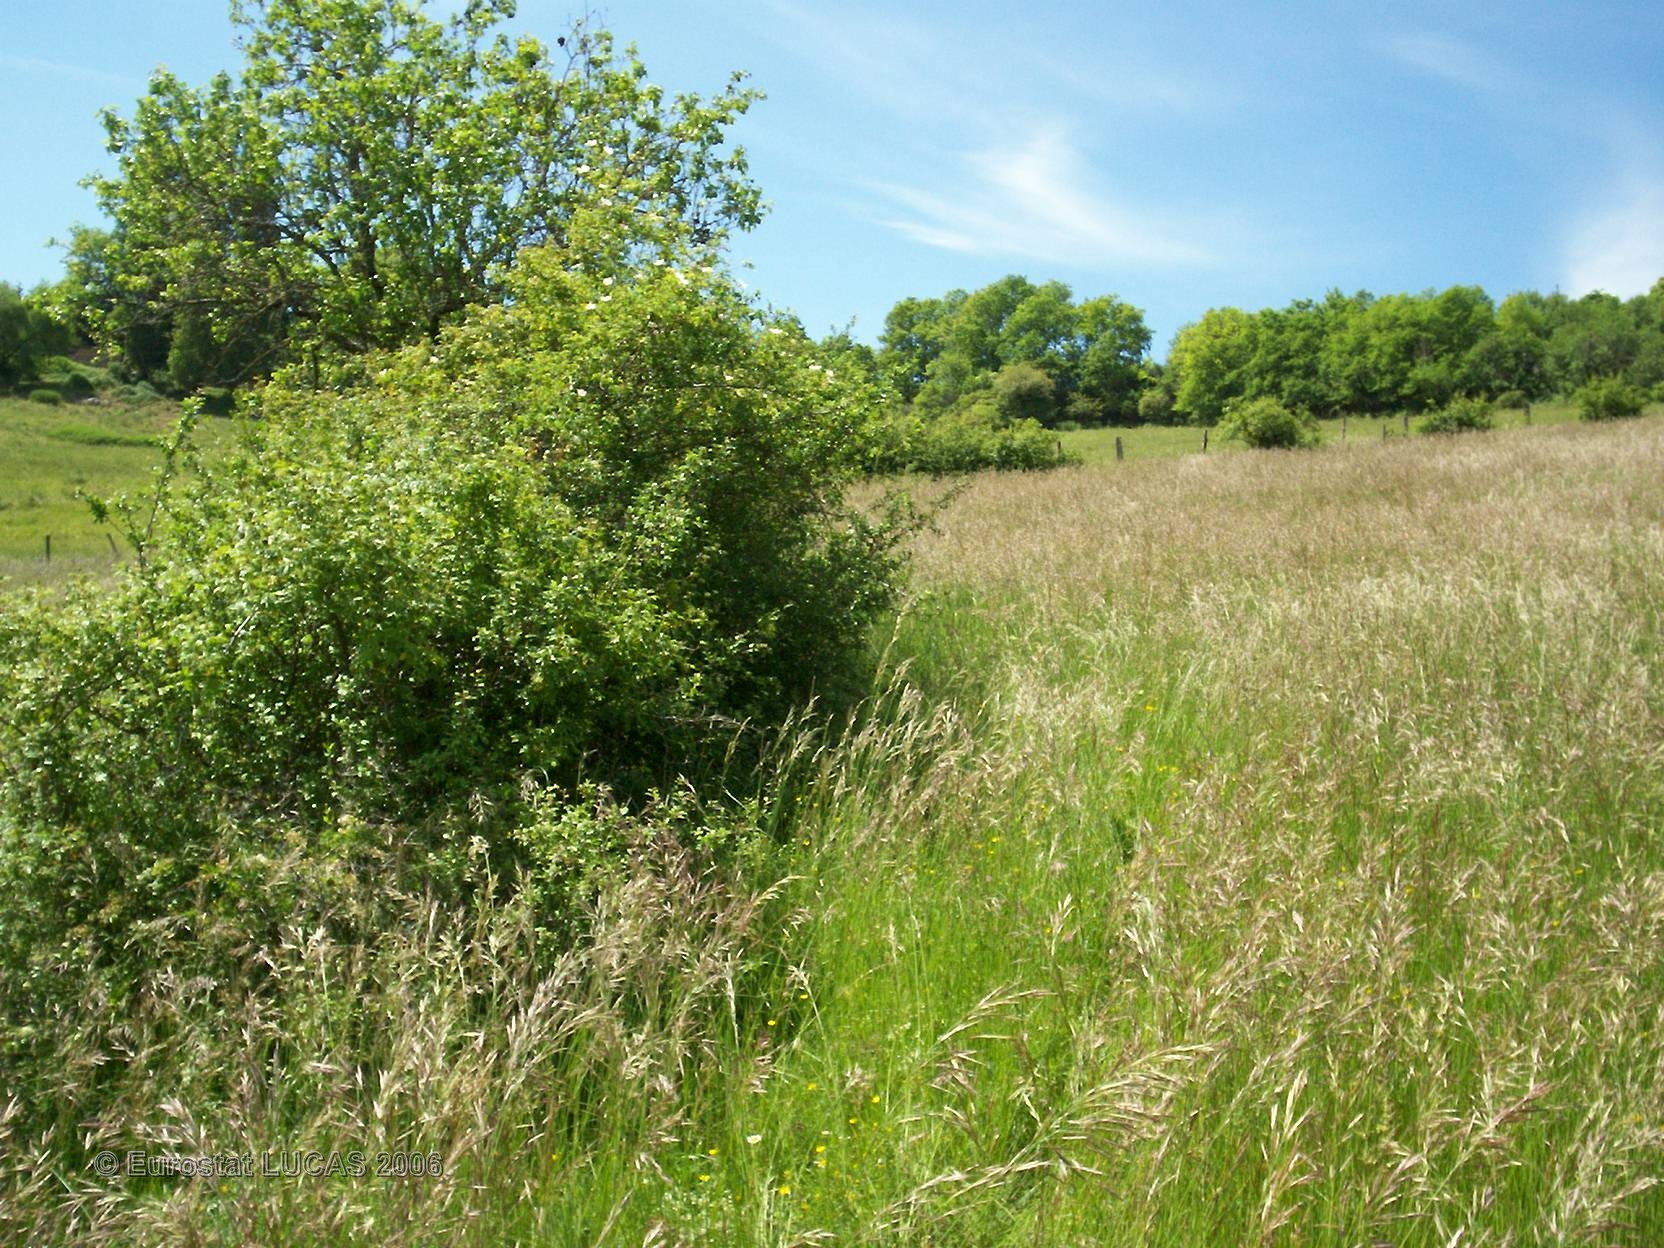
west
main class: Grassland
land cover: Grassland without tree/shrub cover
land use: Agriculture (excluding fallow land and kitchen gardens)
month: May
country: FR
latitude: 44.0934
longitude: 1.9710
